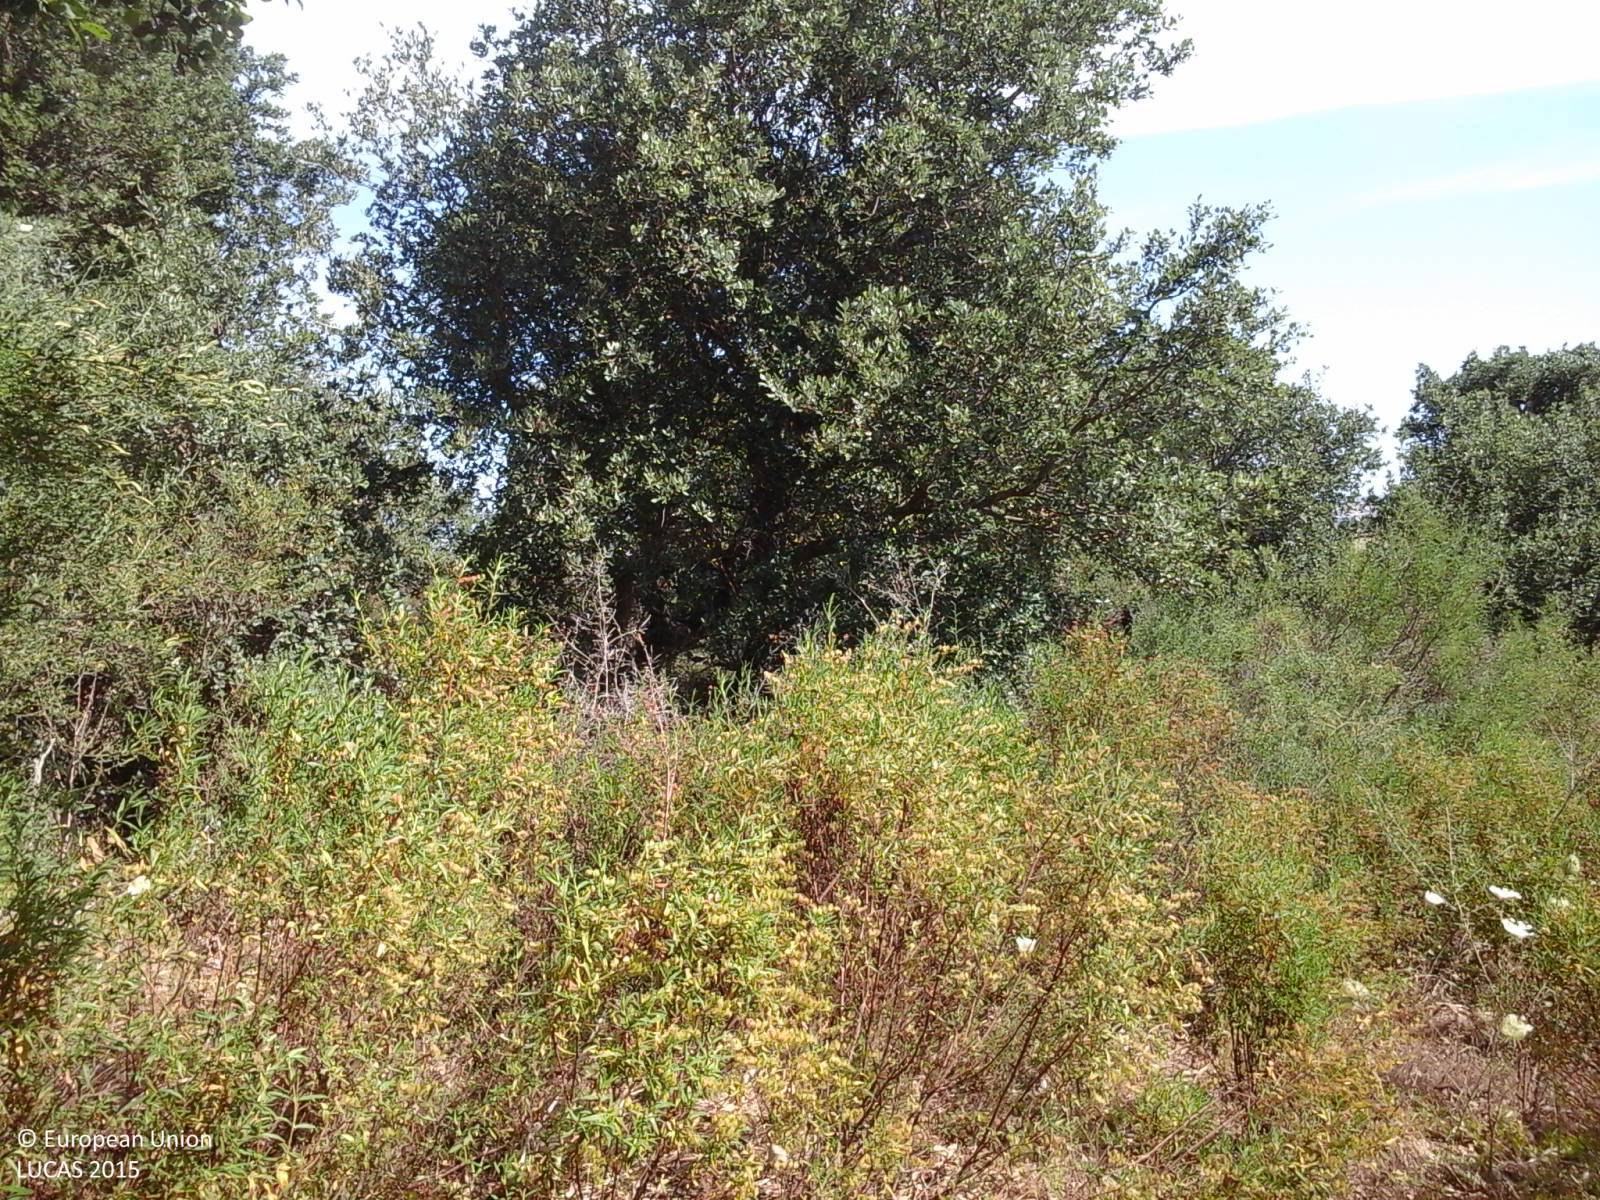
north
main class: Woodland
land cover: Broadleaved woodland
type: broadleaved evergreen forest
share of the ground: 25 - 50 %
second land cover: Grassland without tree/shrub cover
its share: 50 - 75 %
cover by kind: herbaceous plants 45 %, broadleaved forest trees 30 %, shrubs 25 %
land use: Forestry
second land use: Agriculture (excluding fallow land and kitchen gardens)
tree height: > 5 m
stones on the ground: < 10 %
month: June
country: IT
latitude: 40.5814
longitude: 8.4835
